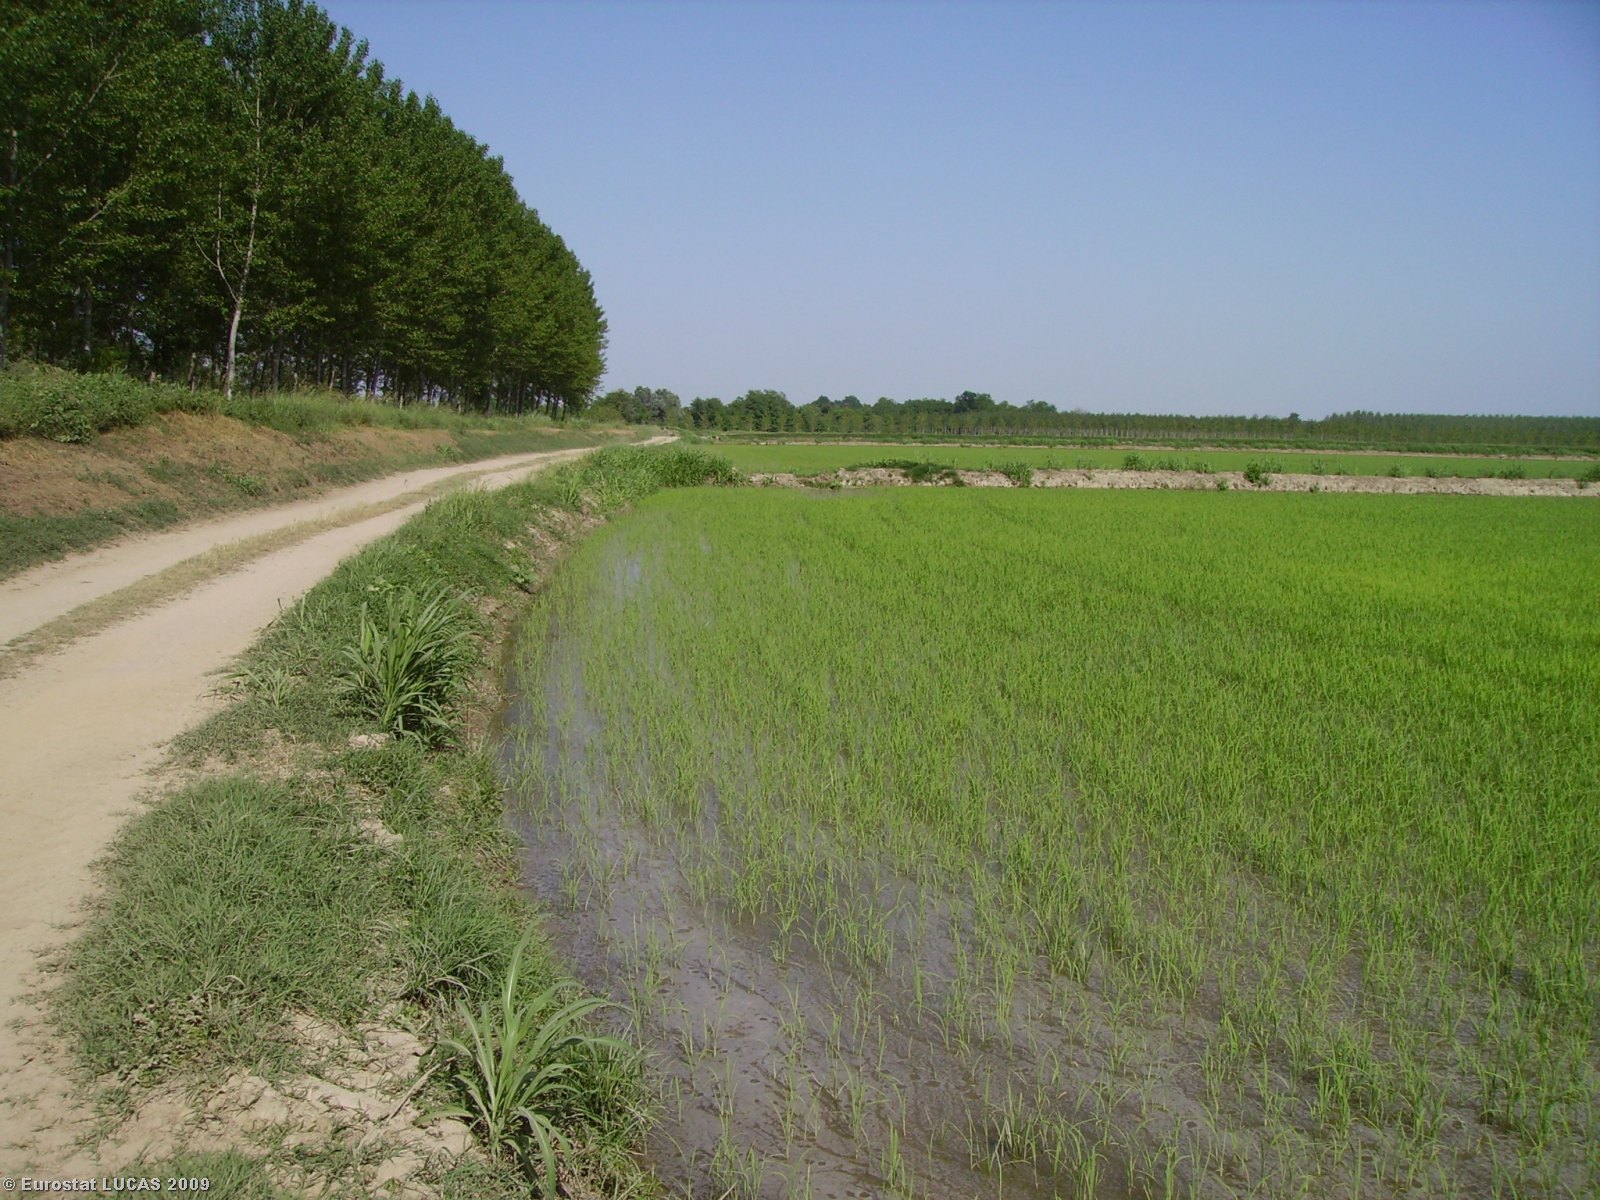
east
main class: Cropland
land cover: Rice
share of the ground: 10 - 25 %
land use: Agriculture (excluding fallow land and kitchen gardens)
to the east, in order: Rice; Grass margins; Rice; Grass margins; Ditches and canals; Grass margins; Rice
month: May
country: IT
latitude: 45.1414
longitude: 9.2765
